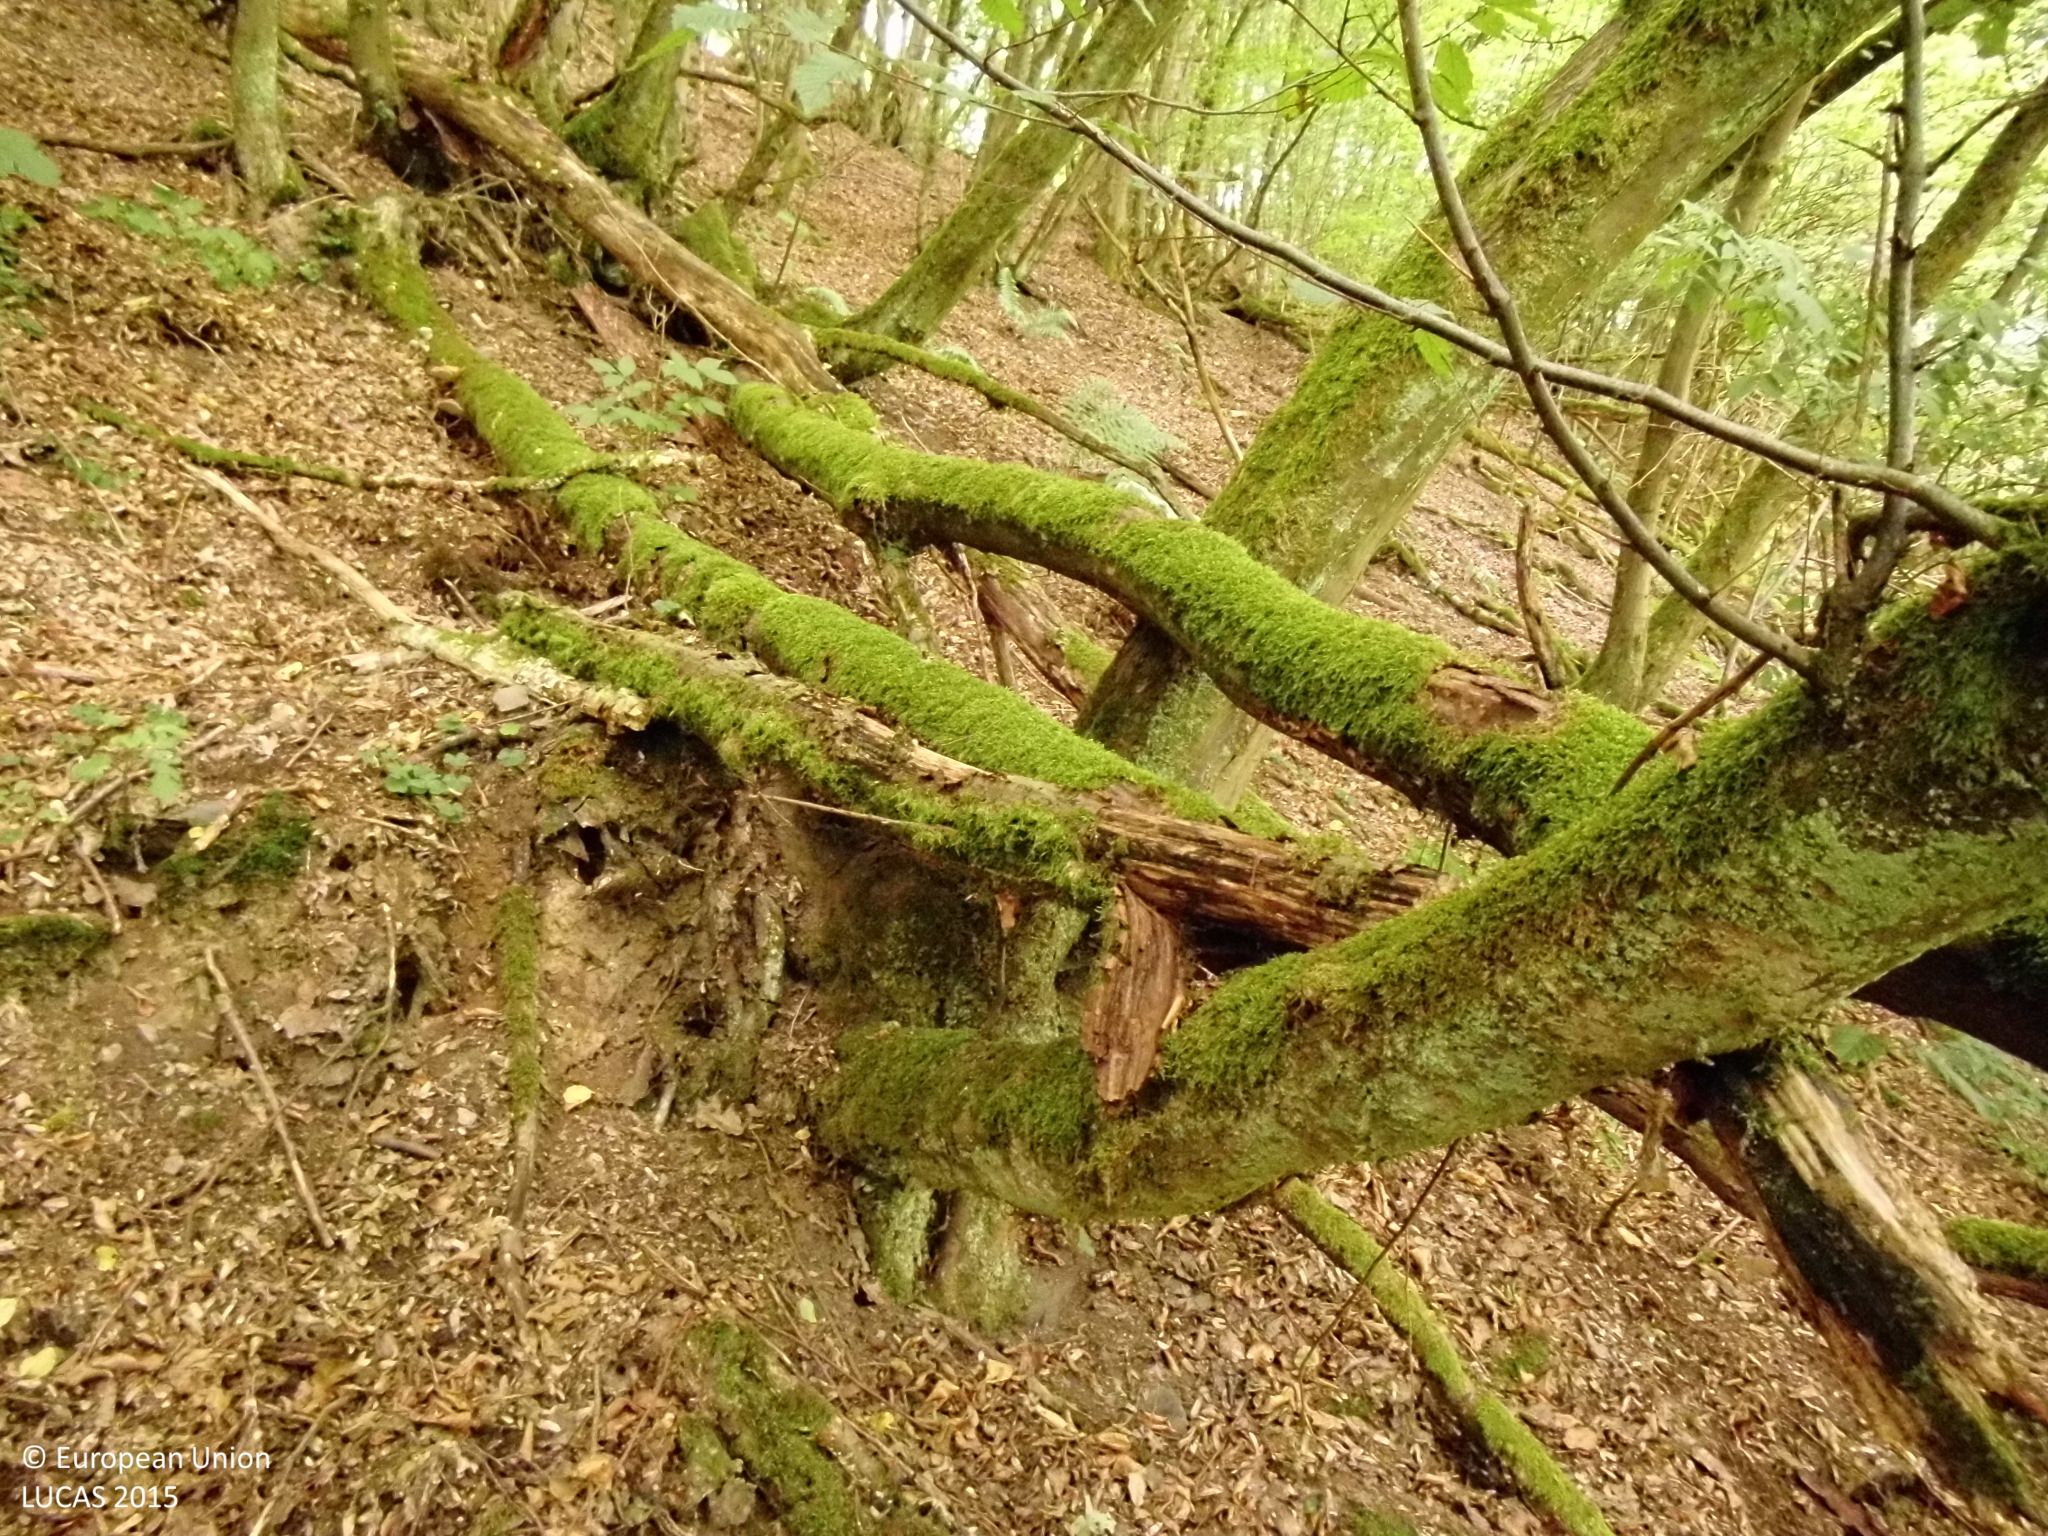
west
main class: Woodland
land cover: Broadleaved woodland
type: mesophytic deciduous forest
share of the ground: > 75 %
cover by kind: broadleaved forest trees 100 %
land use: Forestry
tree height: > 5 m
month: August
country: DE
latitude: 51.0207
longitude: 8.5890
